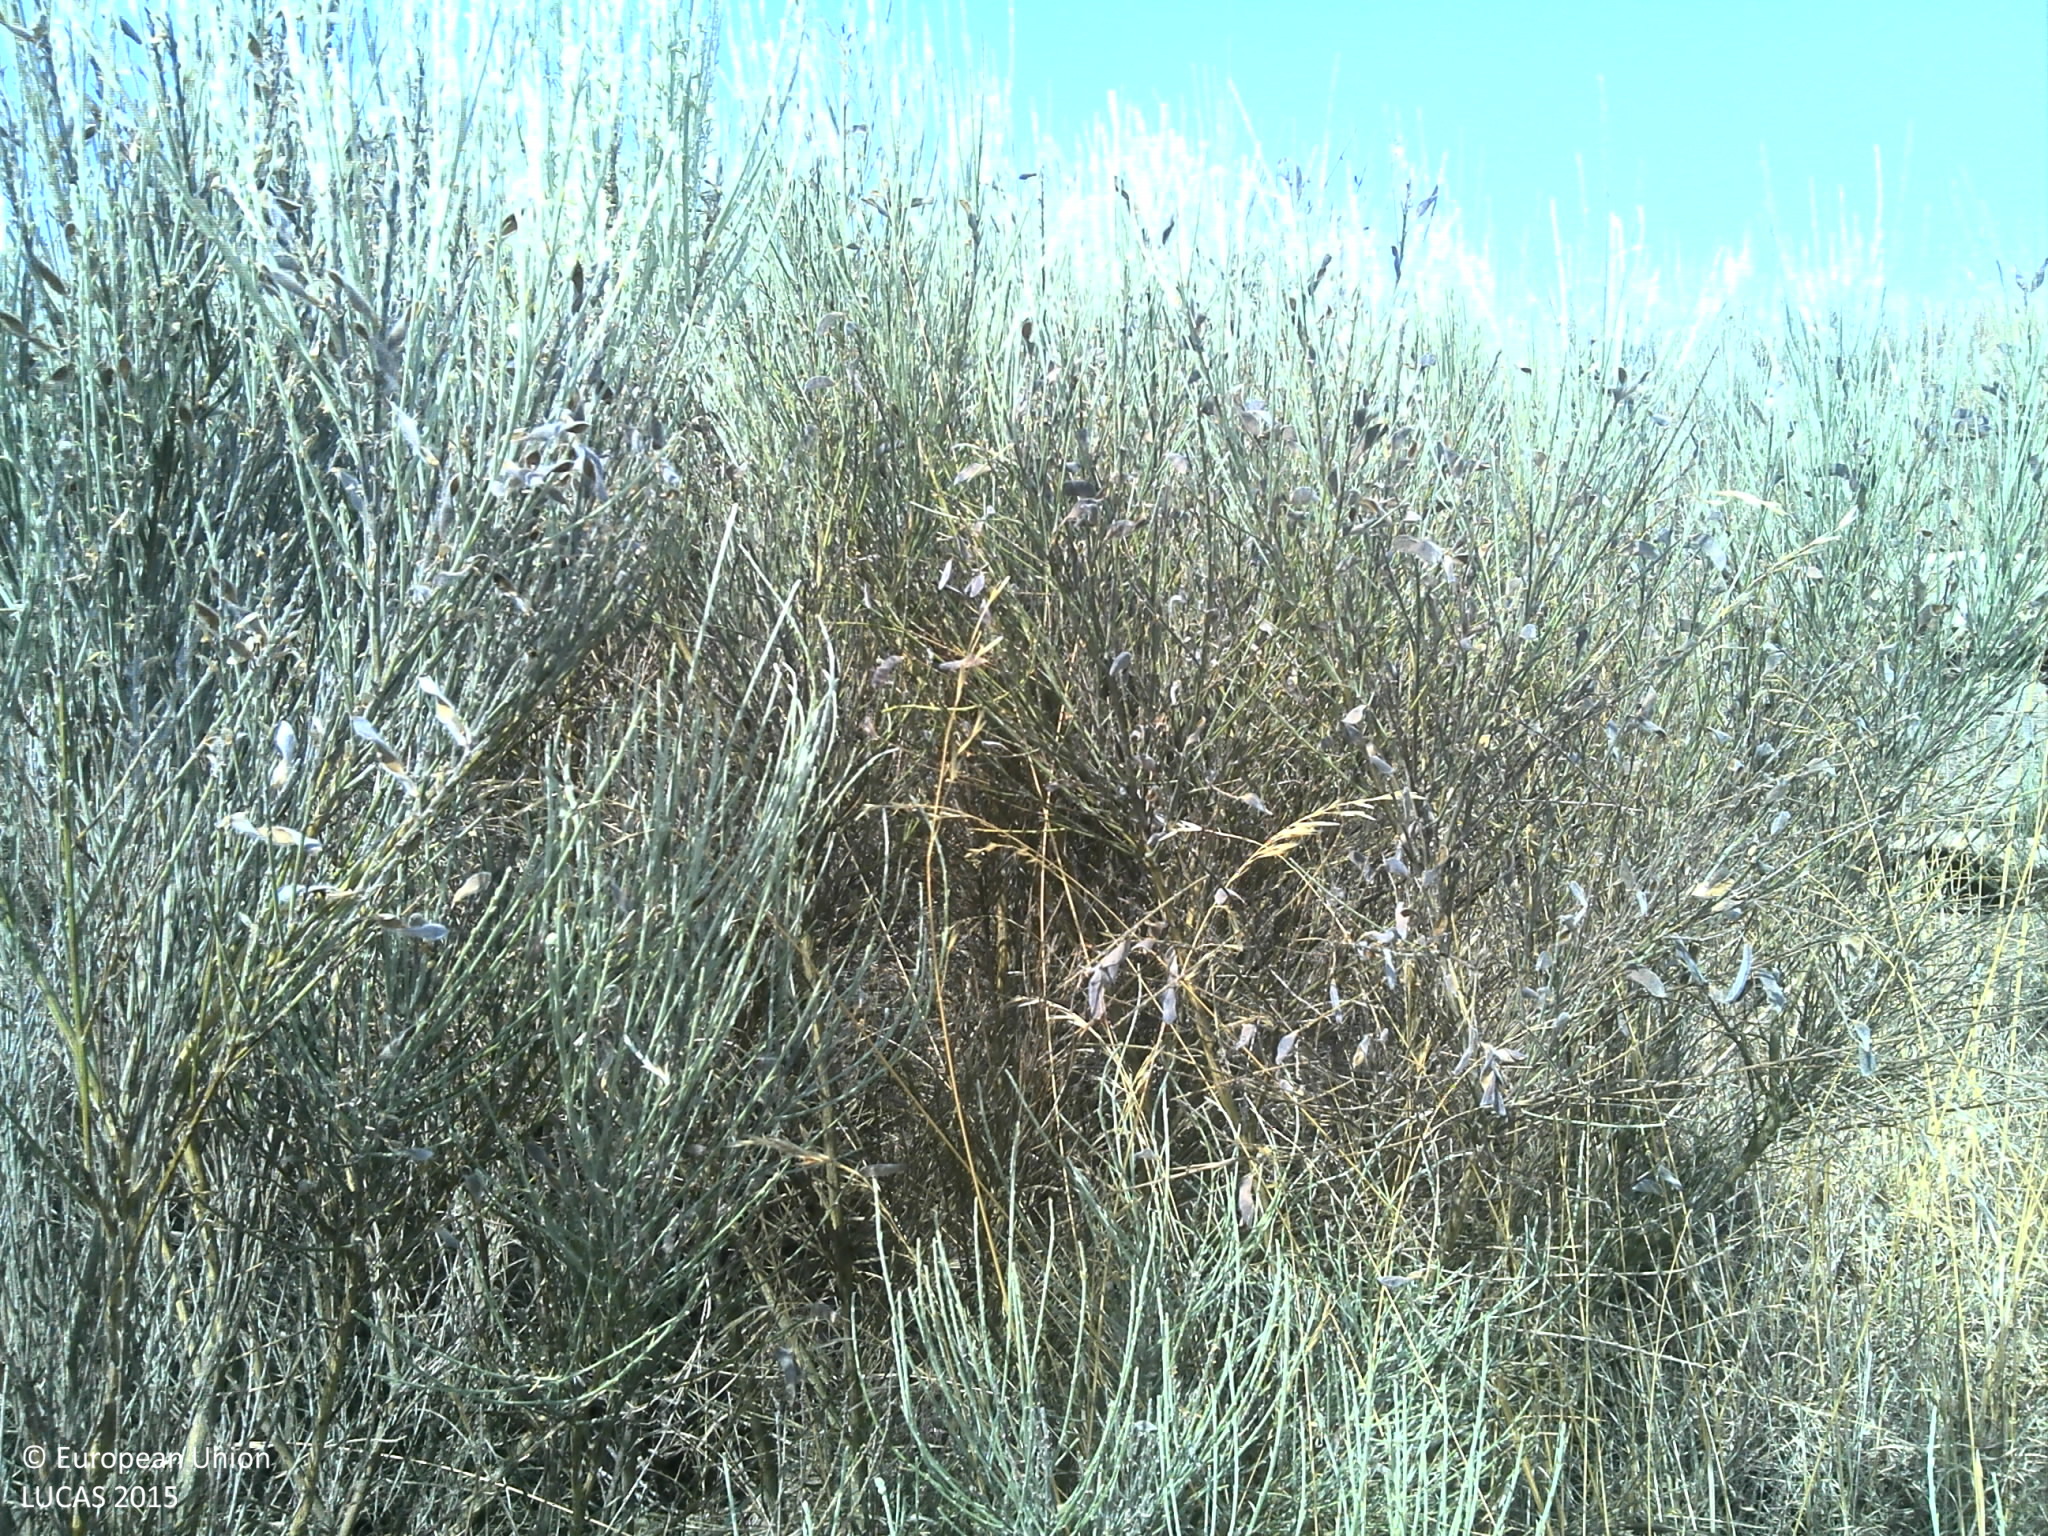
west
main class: Shrubland
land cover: Shrubland without tree cover
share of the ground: 50 - 75 %
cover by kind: shrubs 55 %, herbaceous plants 15 %, consolidated bare surface 15 %, unconsolidated bare surface 15 %
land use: Semi-natural and natural areas not in use
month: July
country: PT
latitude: 40.9539
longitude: -7.3774
